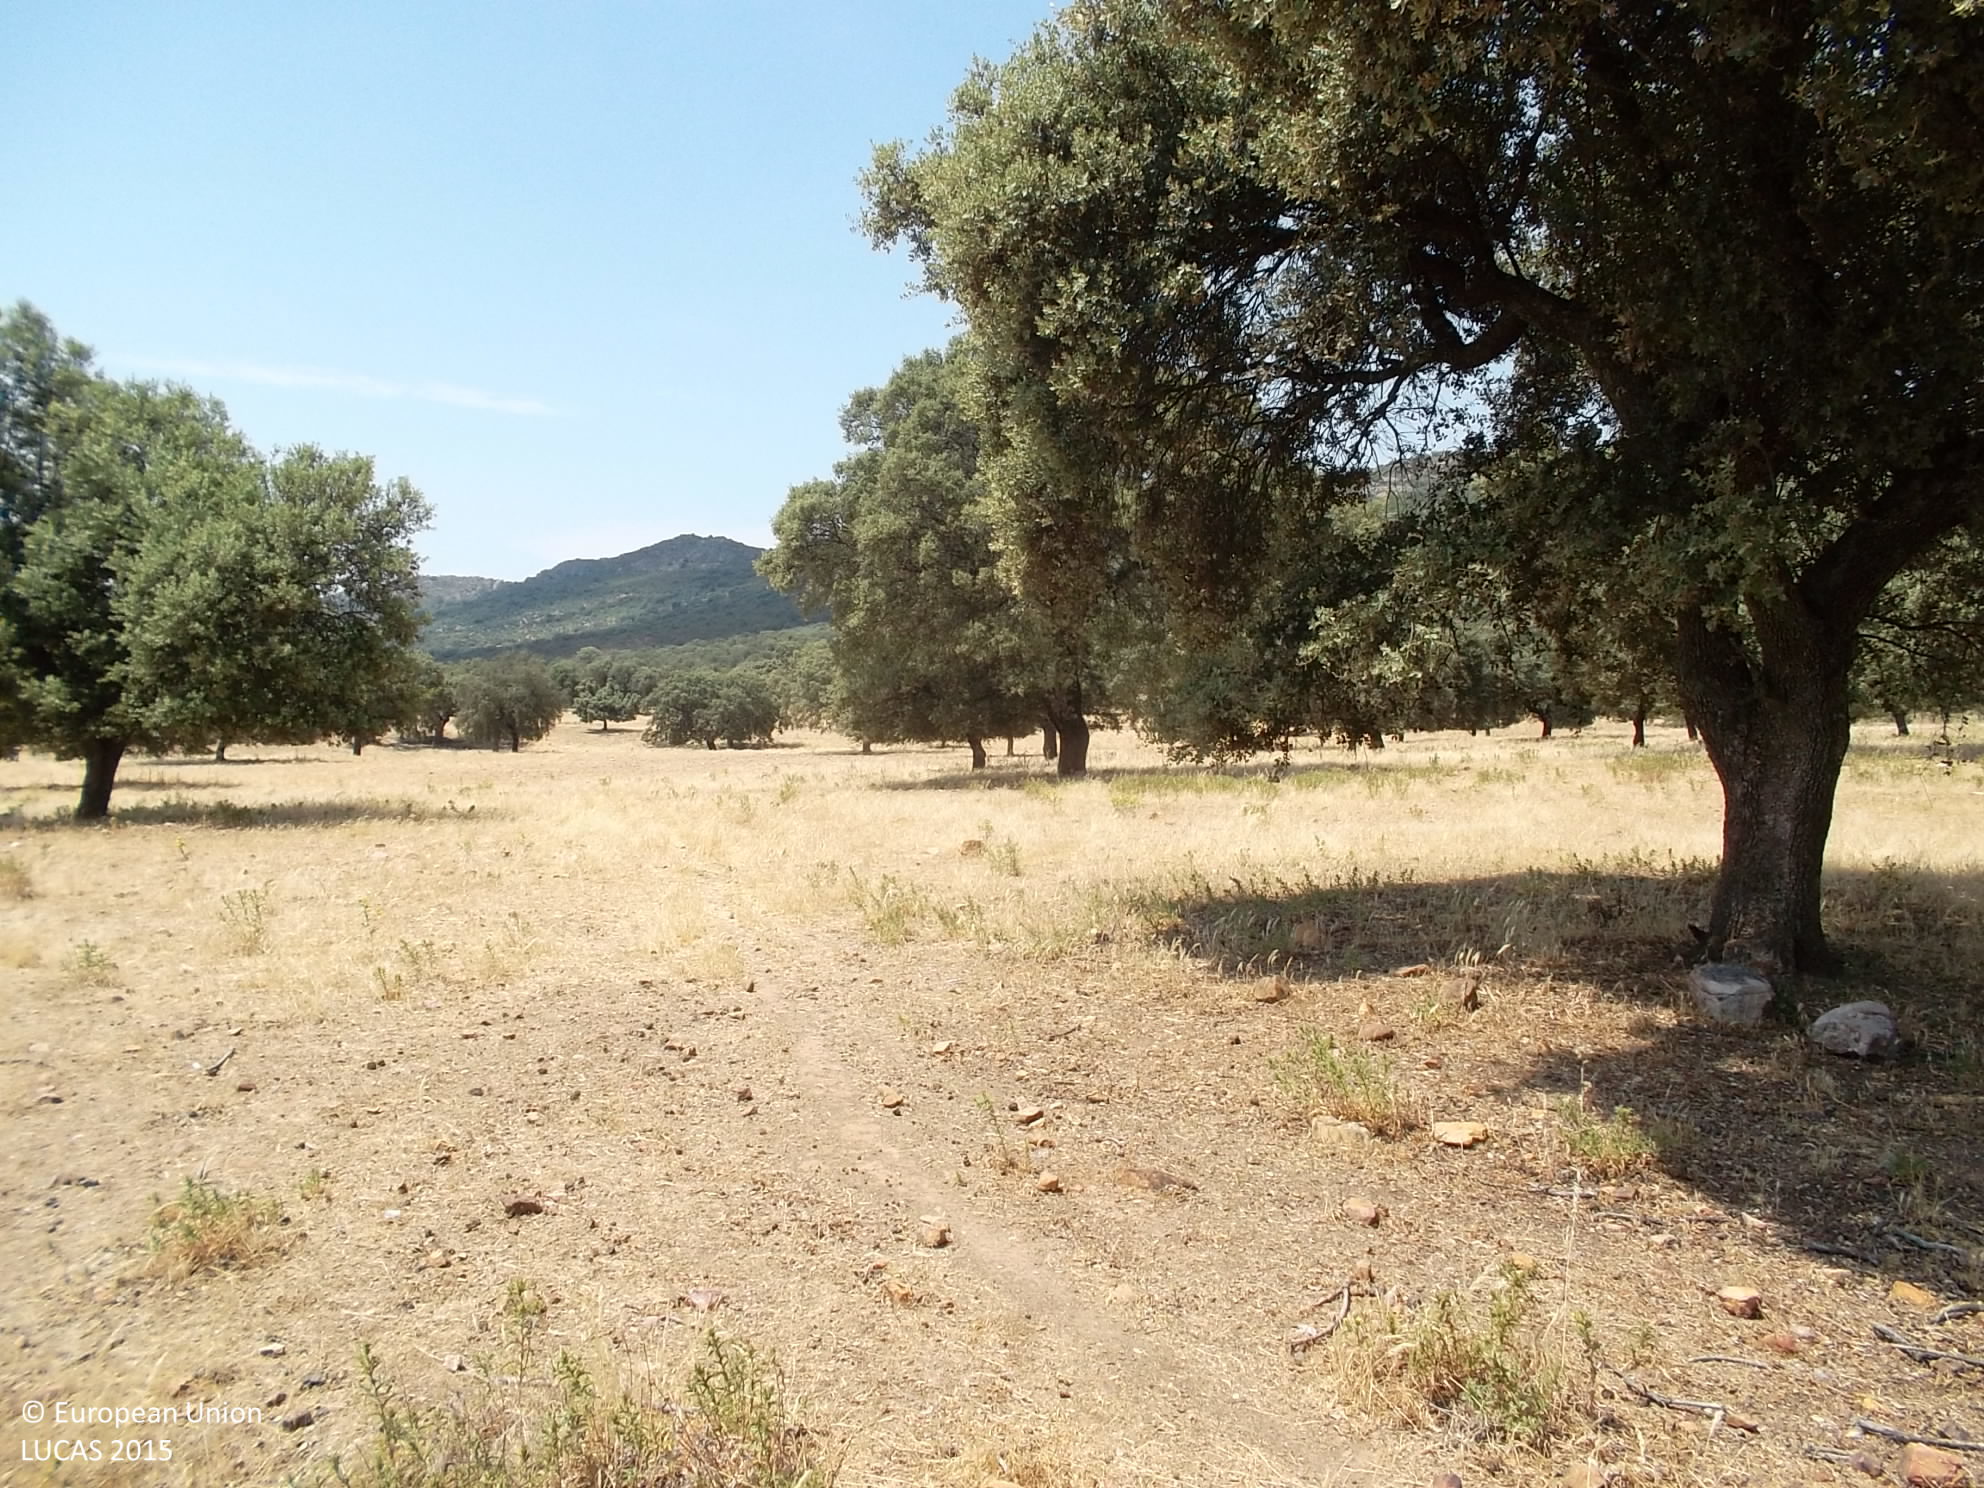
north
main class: Woodland
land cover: Broadleaved woodland
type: broadleaved evergreen forest
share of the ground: 25 - 50 %
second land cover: Spontaneously vegetated surfaces
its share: > 75 %
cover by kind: broadleaved forest trees 50 %, herbaceous plants 50 %
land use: Forestry
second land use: Agriculture (excluding fallow land and kitchen gardens)
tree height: > 5 m
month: June
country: ES
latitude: 39.1864
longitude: -4.9609
